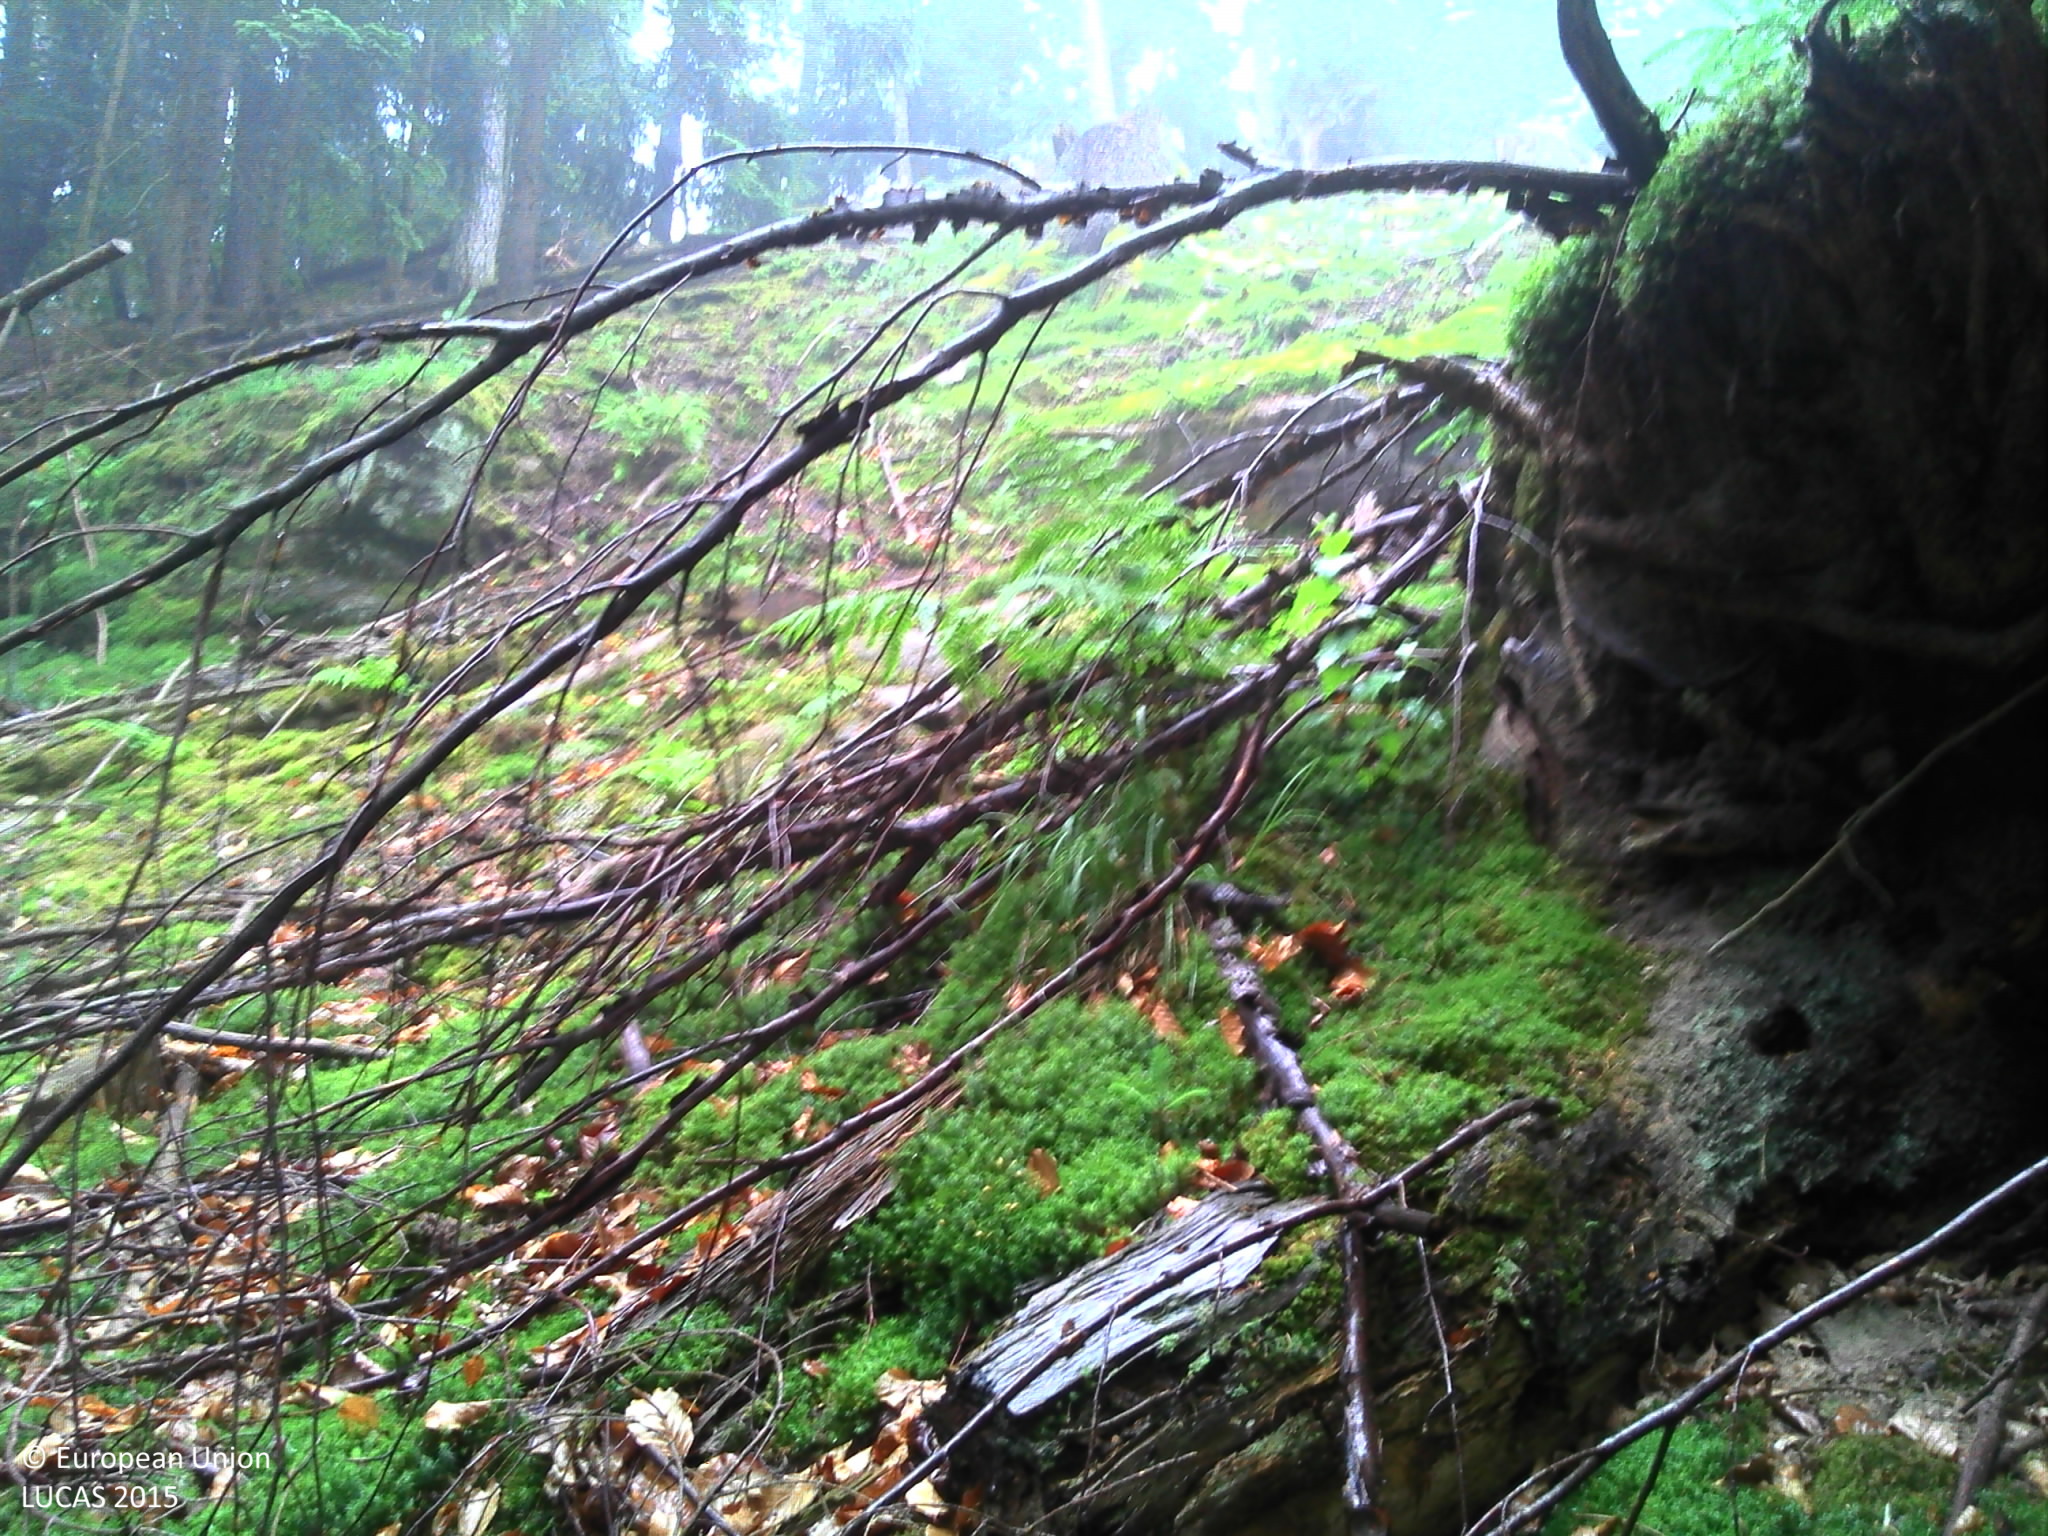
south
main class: Woodland
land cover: Spruce dominated mixed woodland
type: beech forest
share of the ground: > 75 %
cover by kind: coniferous forest trees 65 %, broadleaved forest trees 25 %, shrubs 5 %, herbaceous plants 5 %
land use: Forestry
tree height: > 5 m
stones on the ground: < 10 %
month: June
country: FR
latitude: 48.9919
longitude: 7.7183
